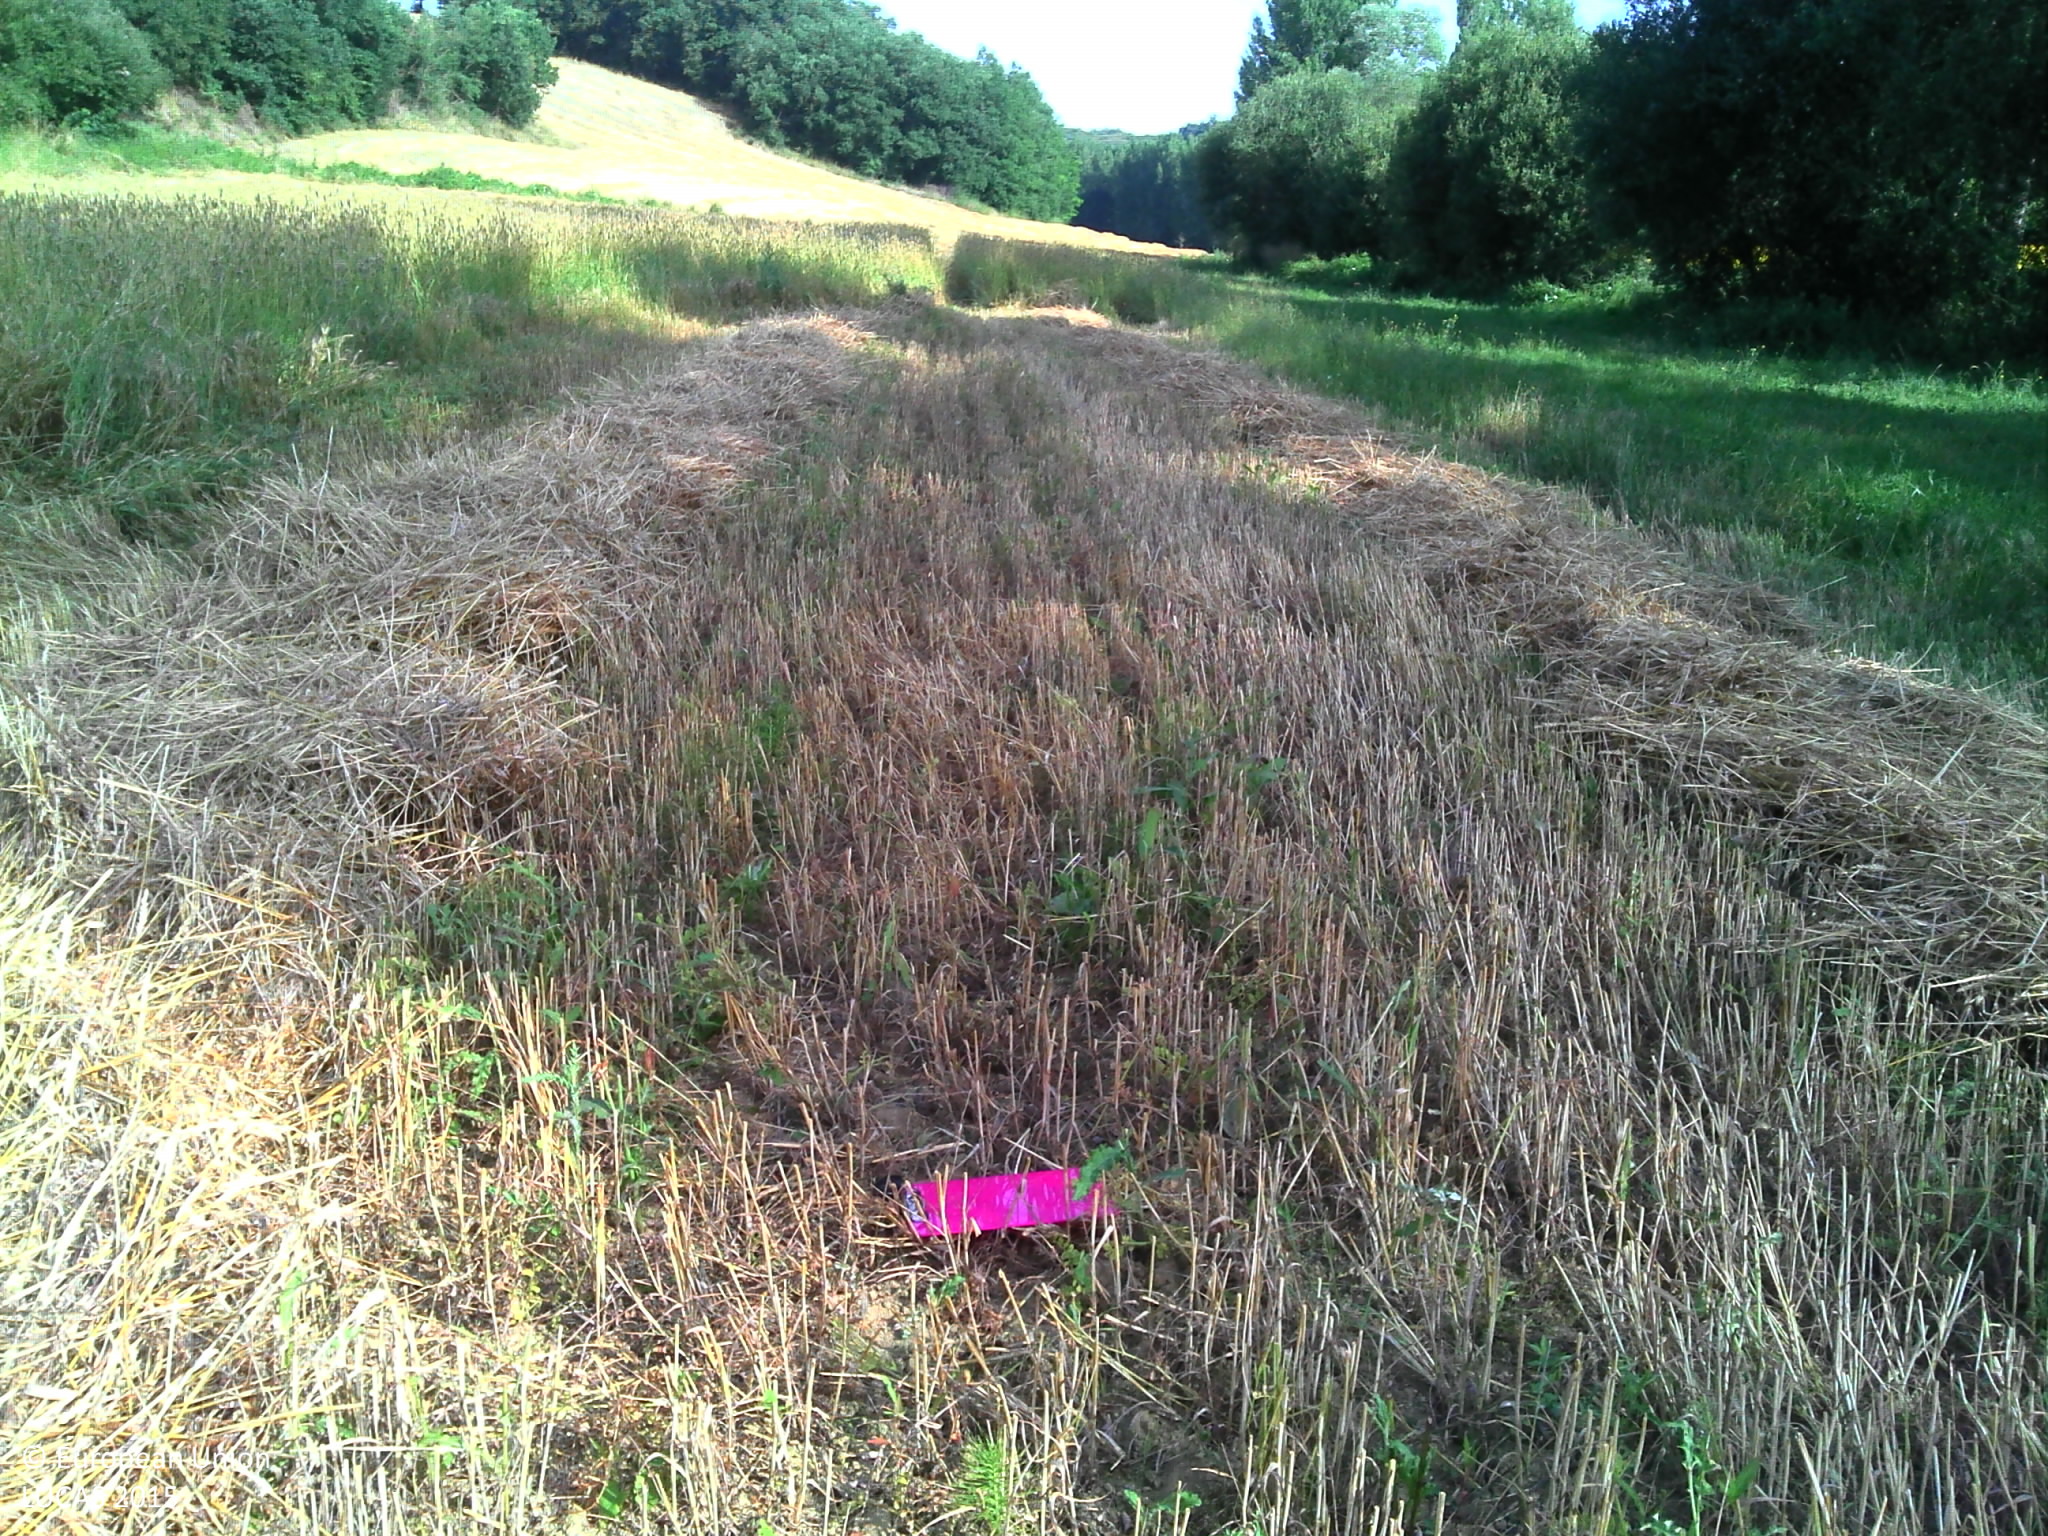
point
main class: Cropland
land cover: Durum wheat
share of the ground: > 75 %
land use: Agriculture (excluding fallow land and kitchen gardens)
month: July
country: FR
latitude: 43.2490
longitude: 1.3951
